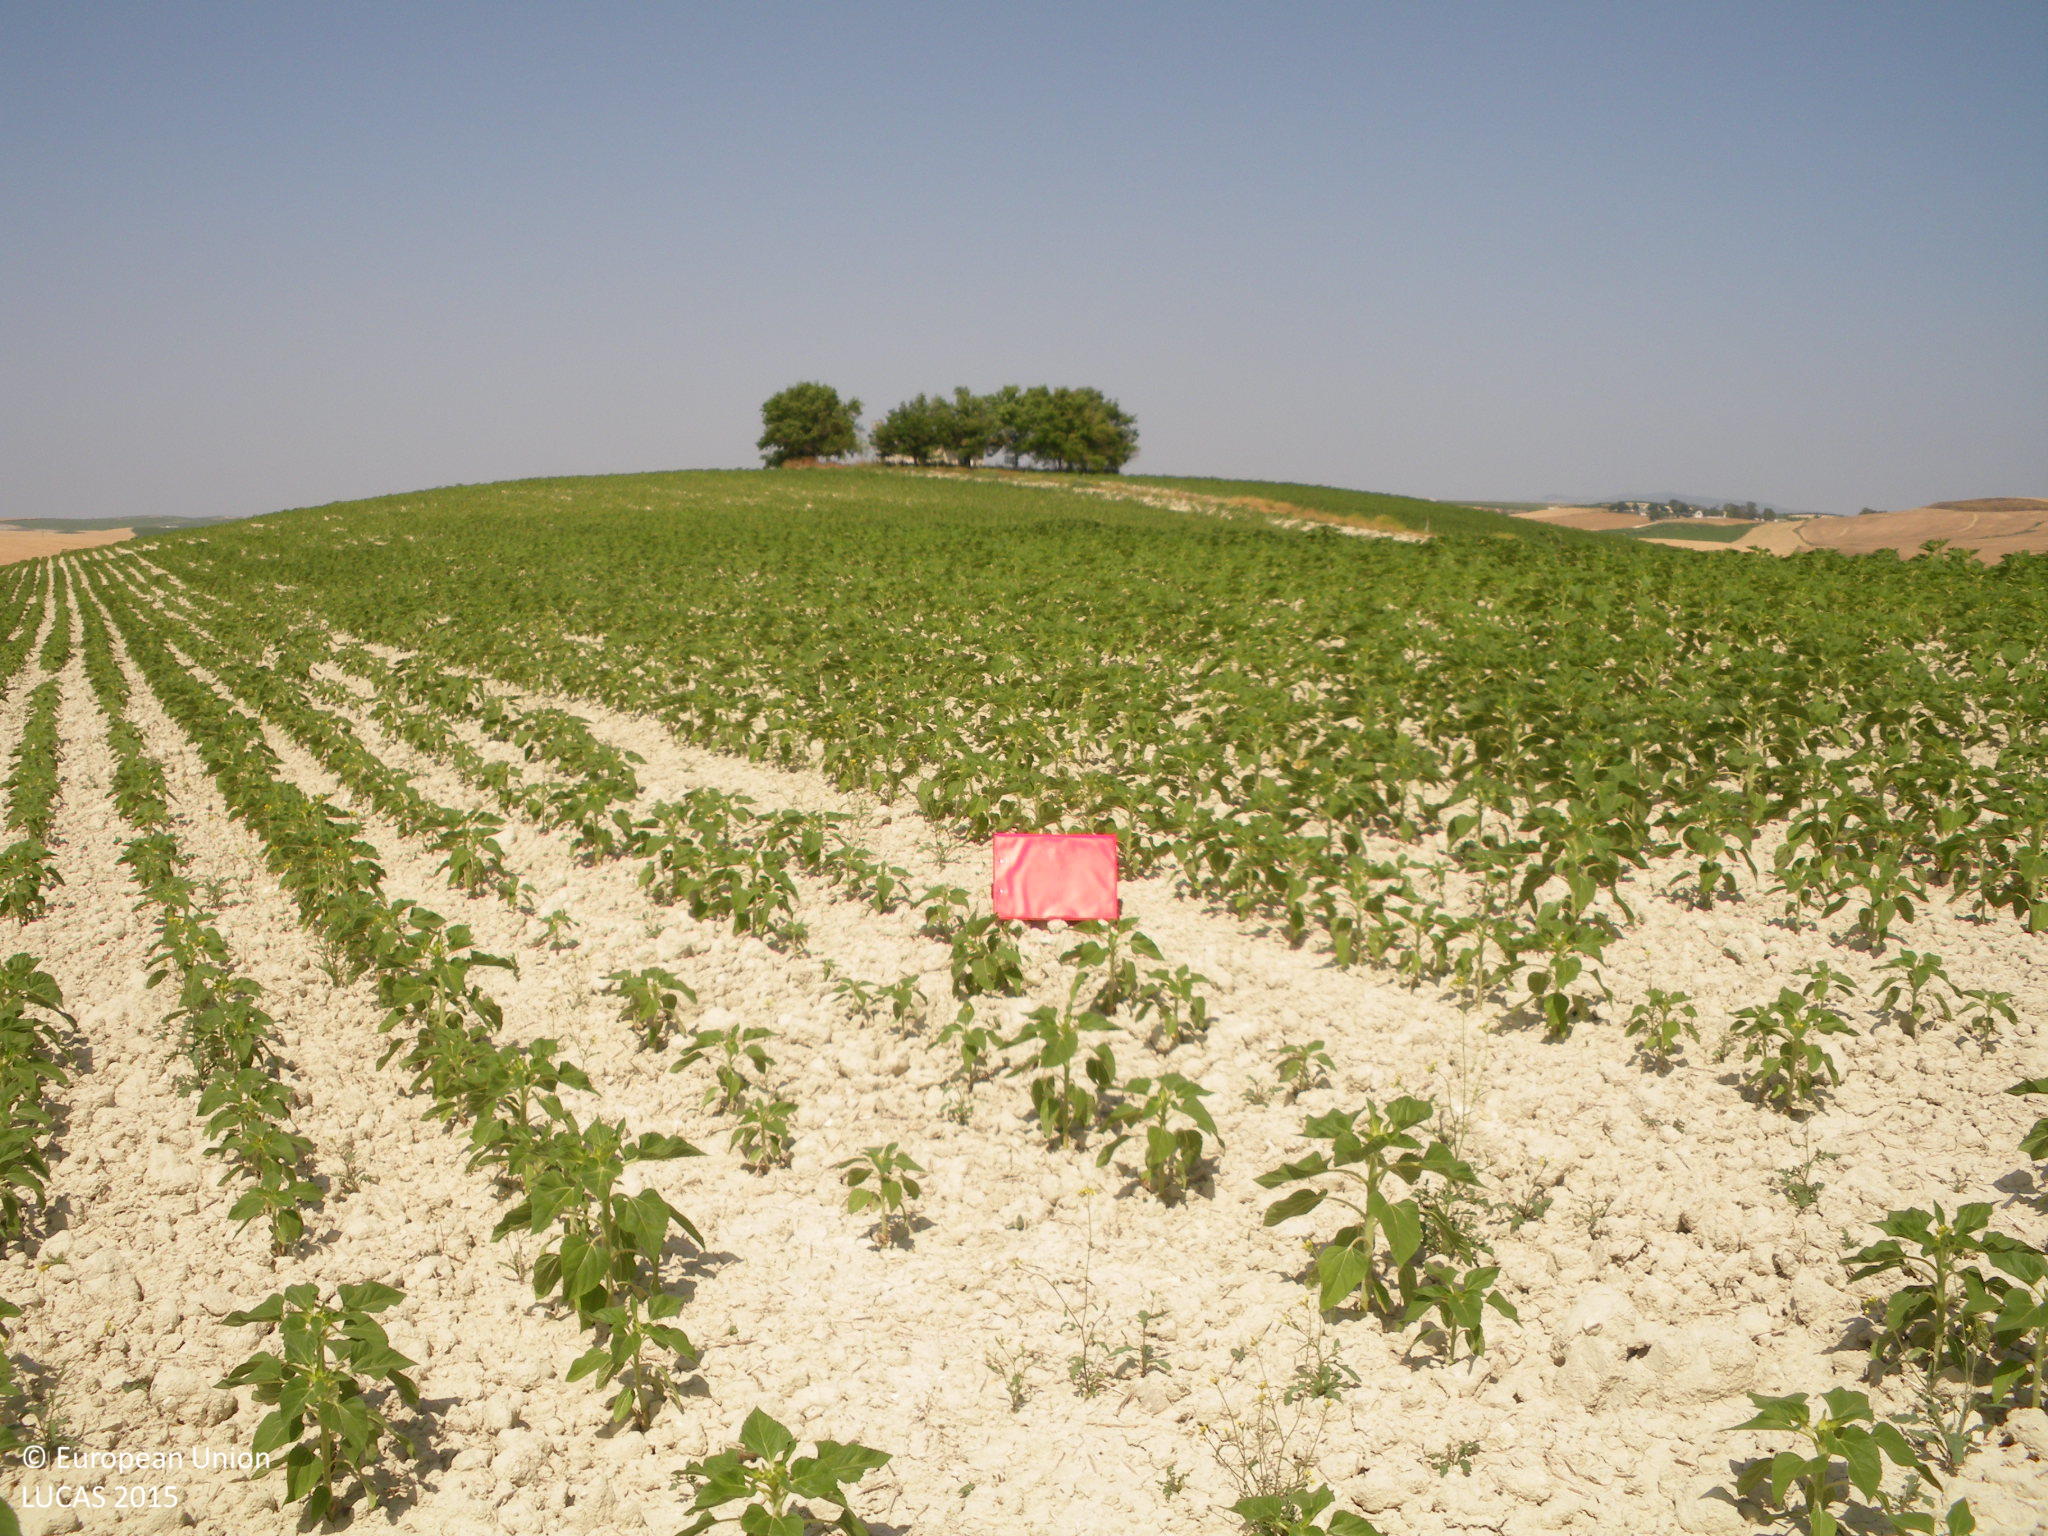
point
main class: Cropland
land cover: Sunflower
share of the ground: 10 - 25 %
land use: Agriculture (excluding fallow land and kitchen gardens)
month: May
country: ES
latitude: 36.7898
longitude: -6.2085
